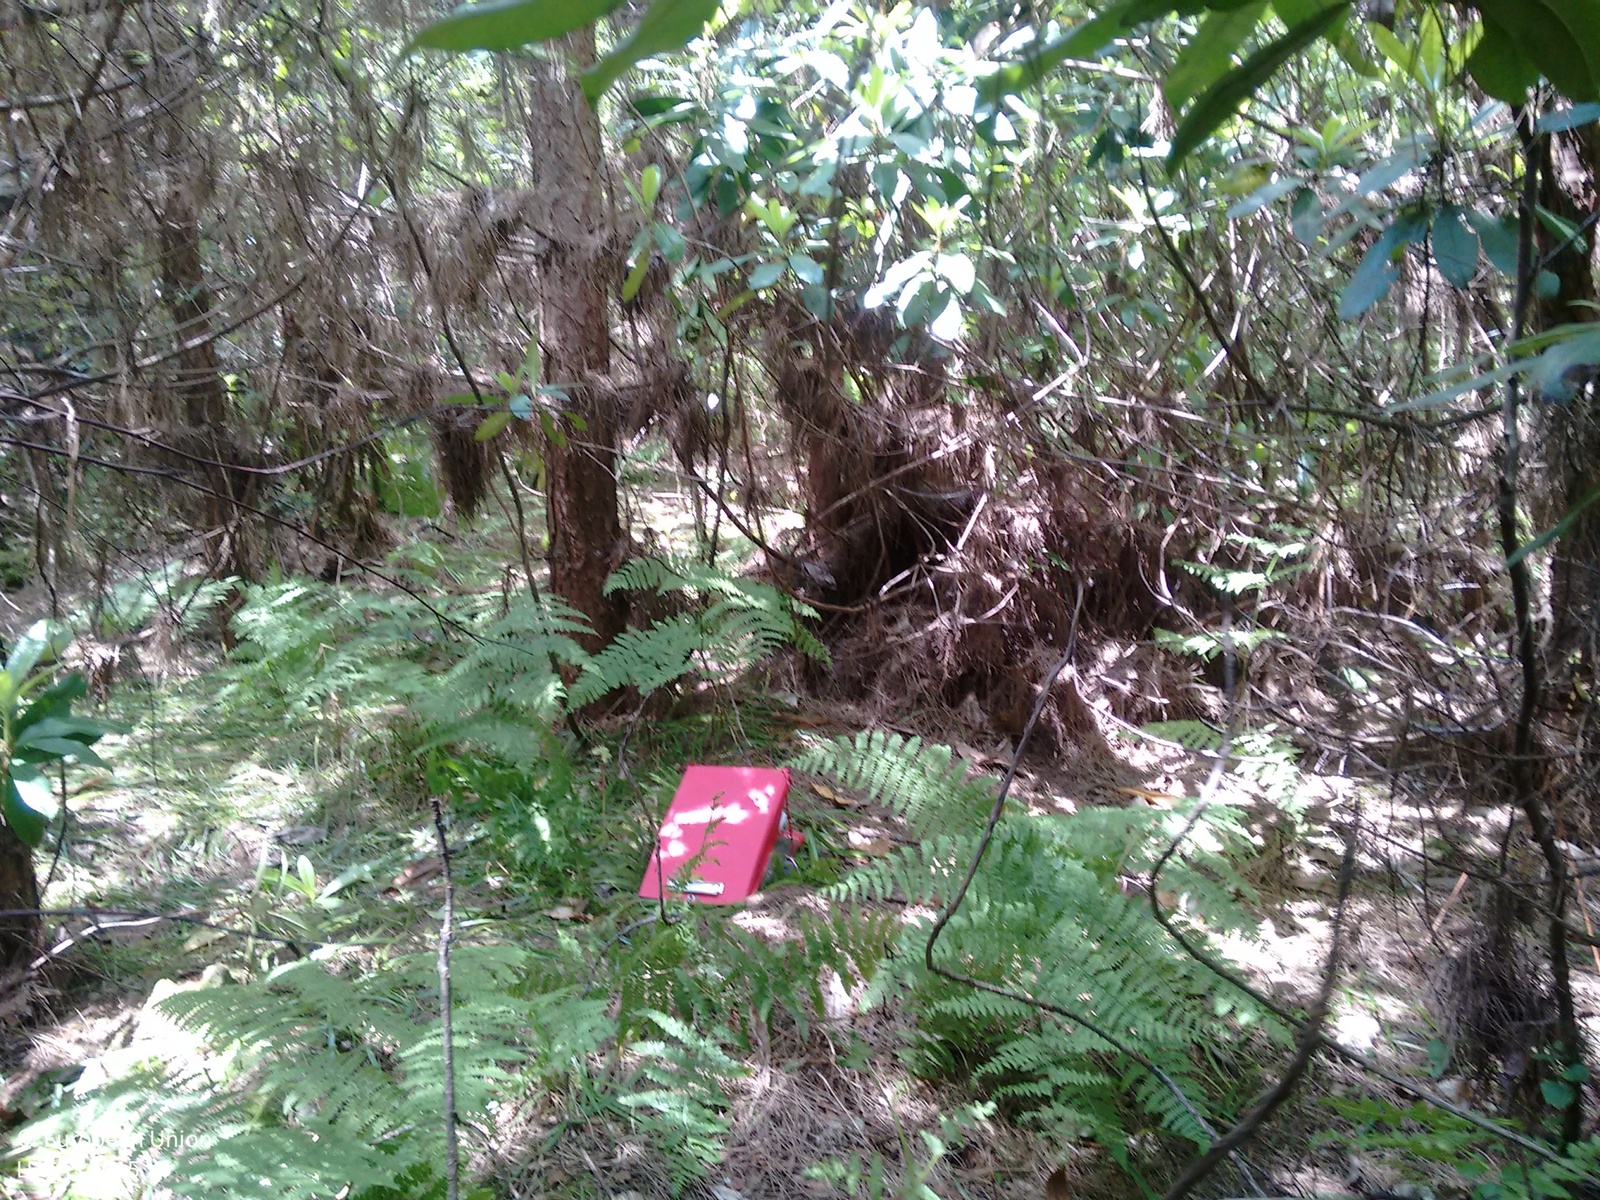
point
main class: Woodland
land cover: Pine dominated coniferous woodland
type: exotic forest
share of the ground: > 75 %
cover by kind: coniferous forest trees 95 %, shrubs 5 %
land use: Forestry
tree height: > 5 m
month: June
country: GB
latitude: 51.0979
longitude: 0.5911
